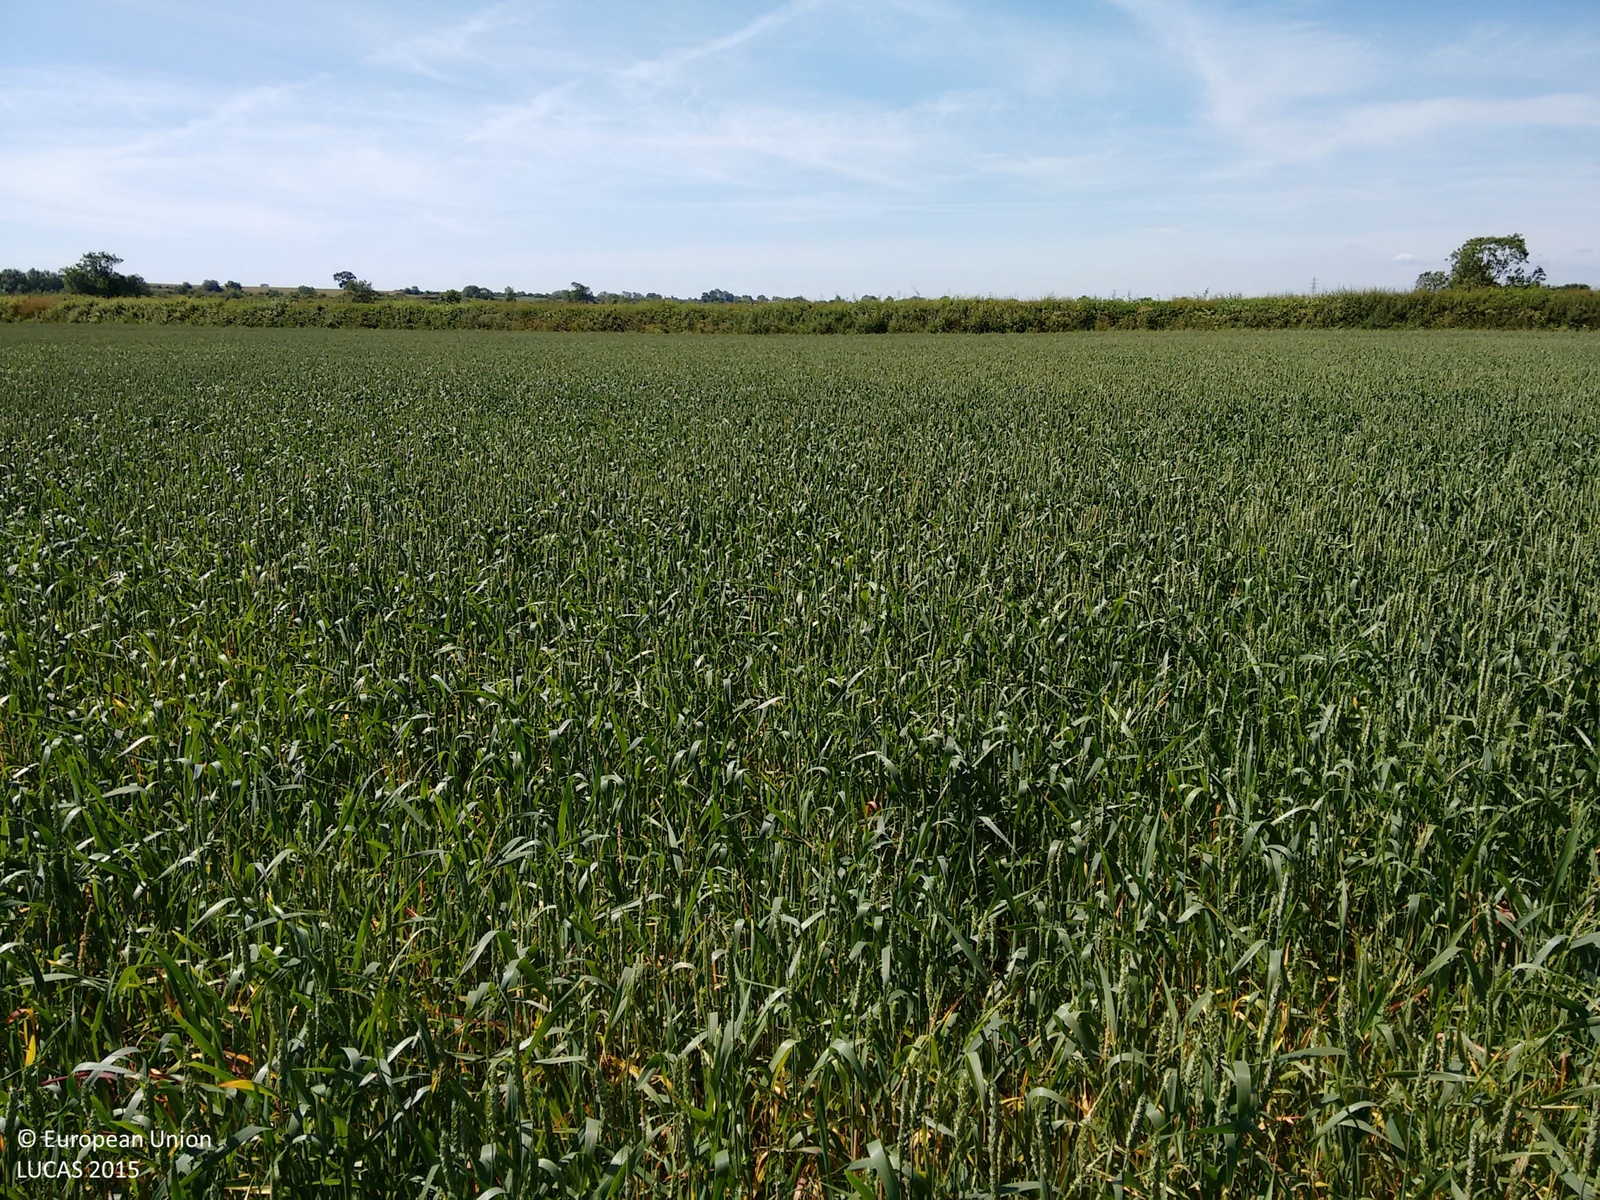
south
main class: Cropland
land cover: Common wheat
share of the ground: > 75 %
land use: Agriculture (excluding fallow land and kitchen gardens)
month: July
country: GB
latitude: 52.9126
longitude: -0.8530
